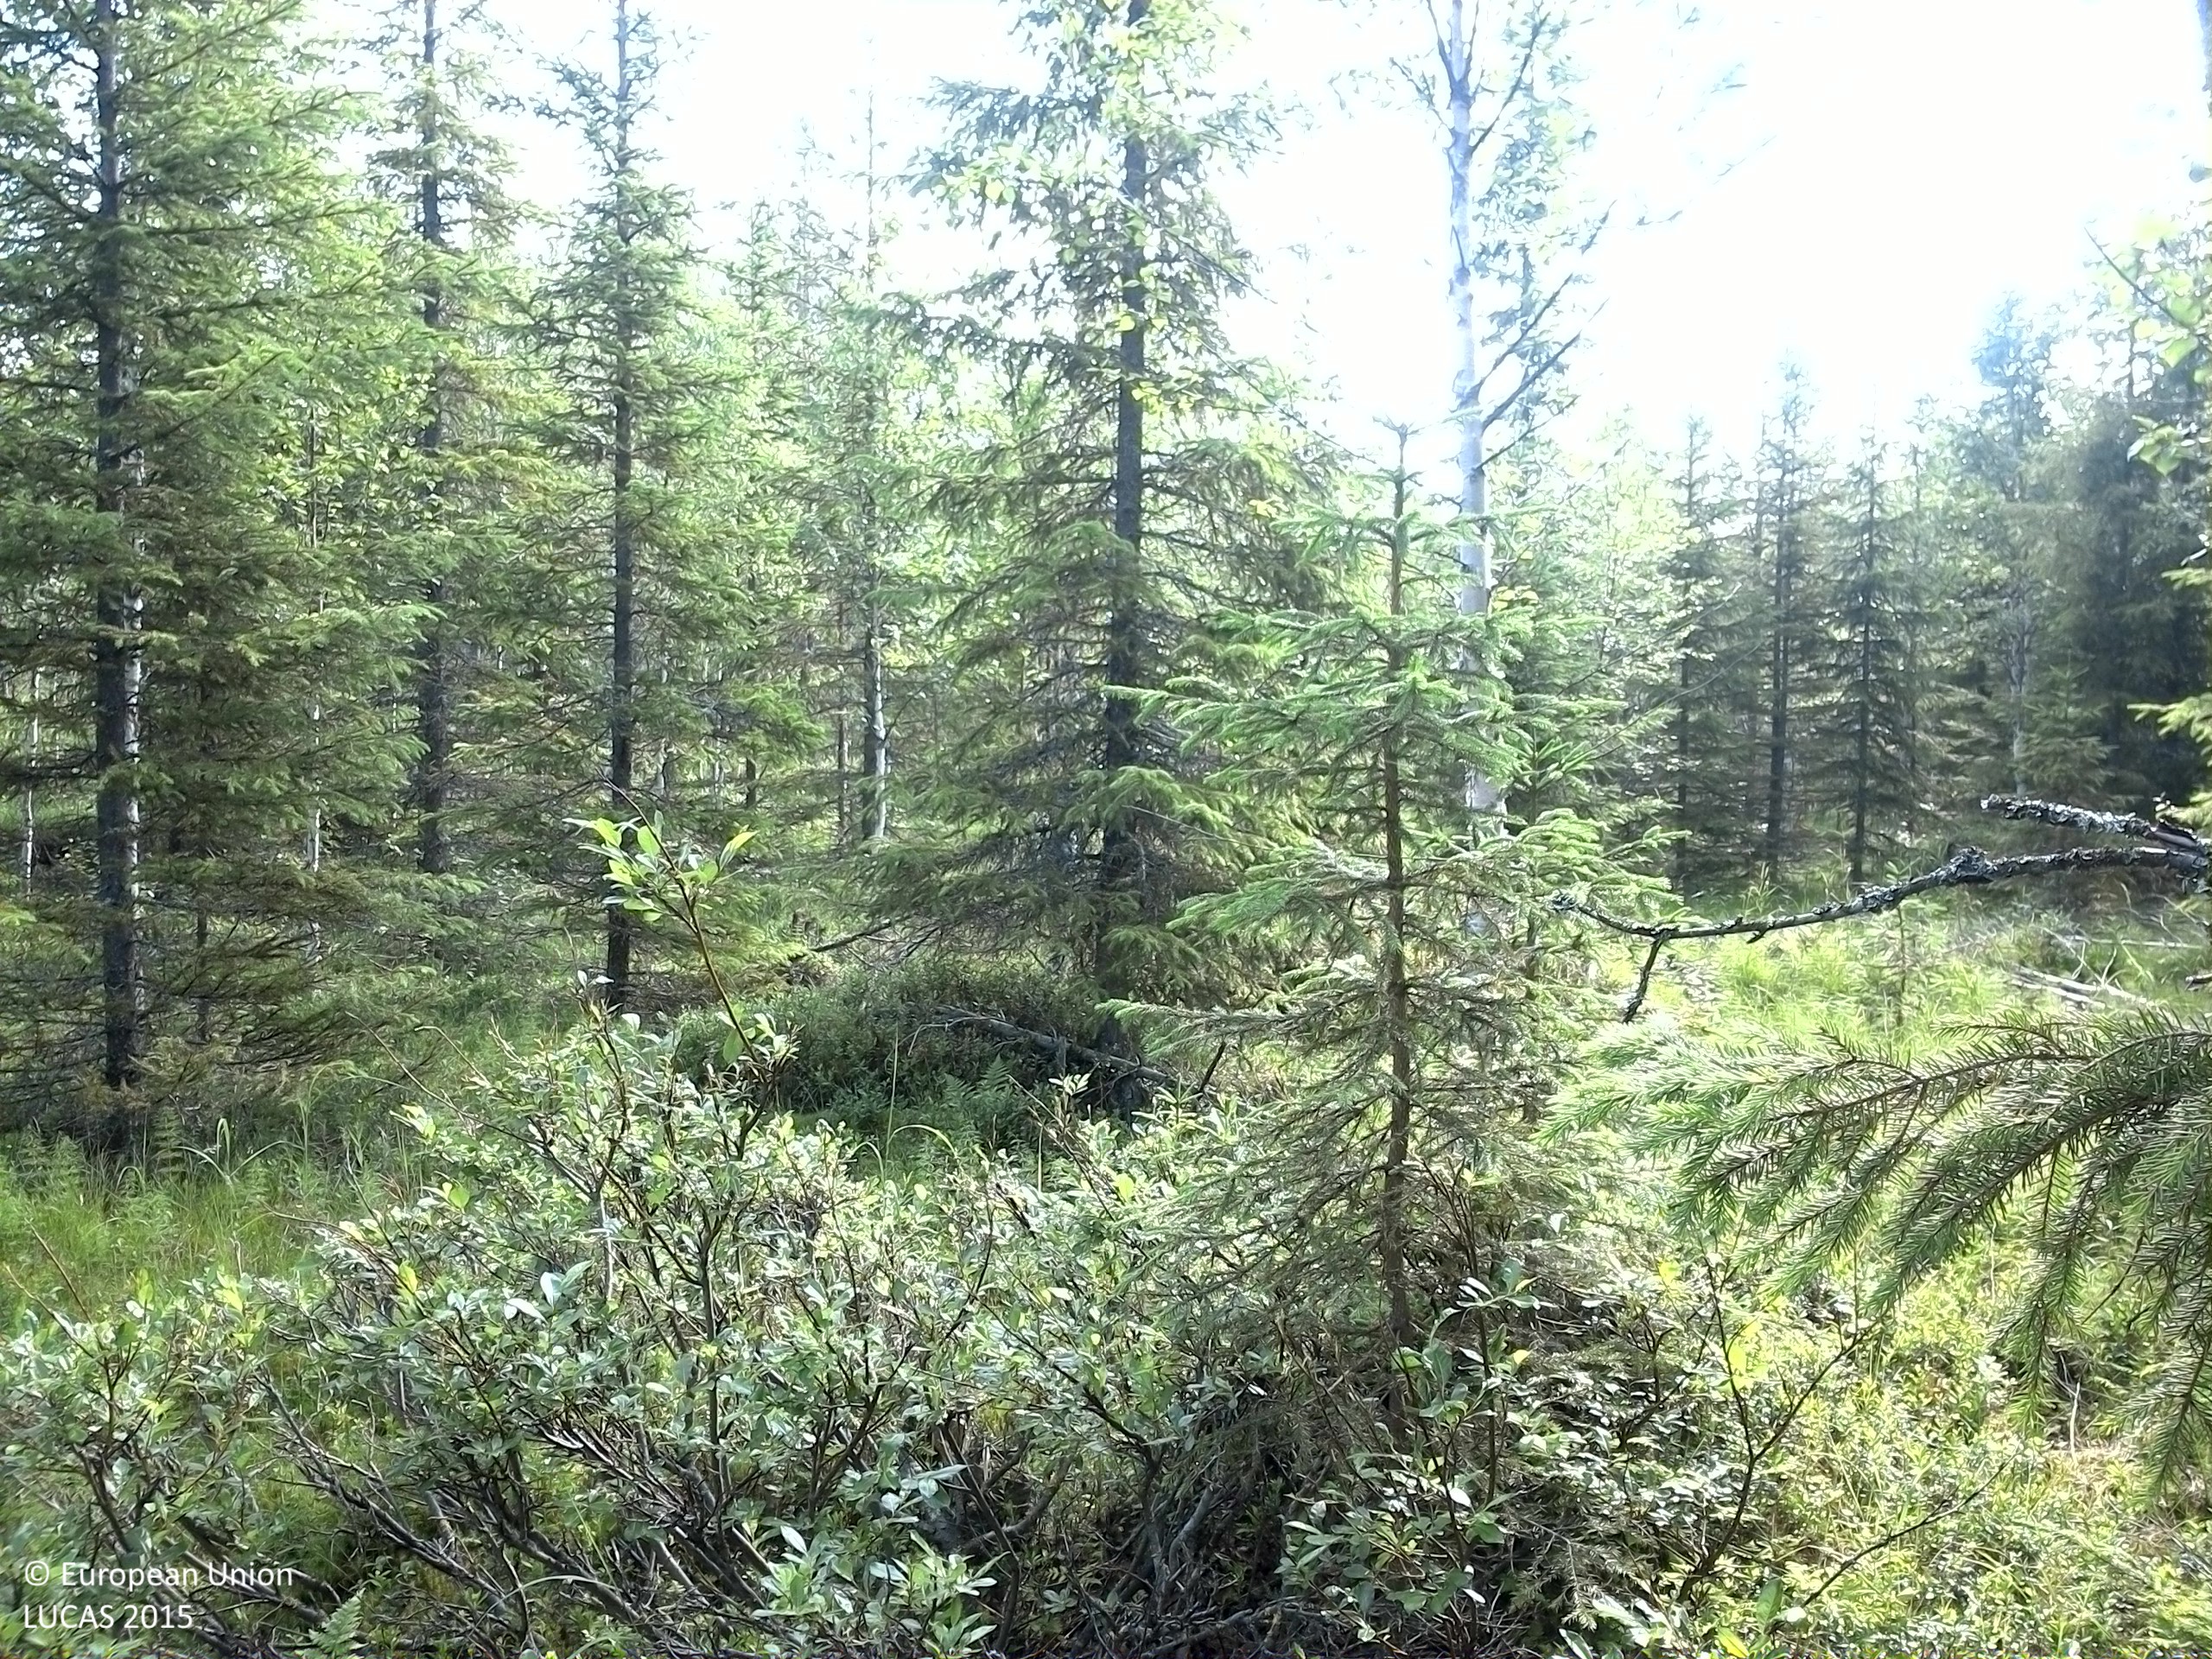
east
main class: Woodland
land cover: Spruce dominated mixed woodland
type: boreal forest
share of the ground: > 75 %
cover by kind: coniferous forest trees 45 %, broadleaved forest trees 25 %, herbaceous plants 15 %, lichens and mosses 10 %, shrubs 5 %
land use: Forestry
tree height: > 5 m
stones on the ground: 25 - 50 %
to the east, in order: Spruce dominated mixed woodland; Rivers and streams; Spruce dominated mixed woodland; Pine dominated coniferous woodland
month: July
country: SE
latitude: 63.5683
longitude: 17.4842
